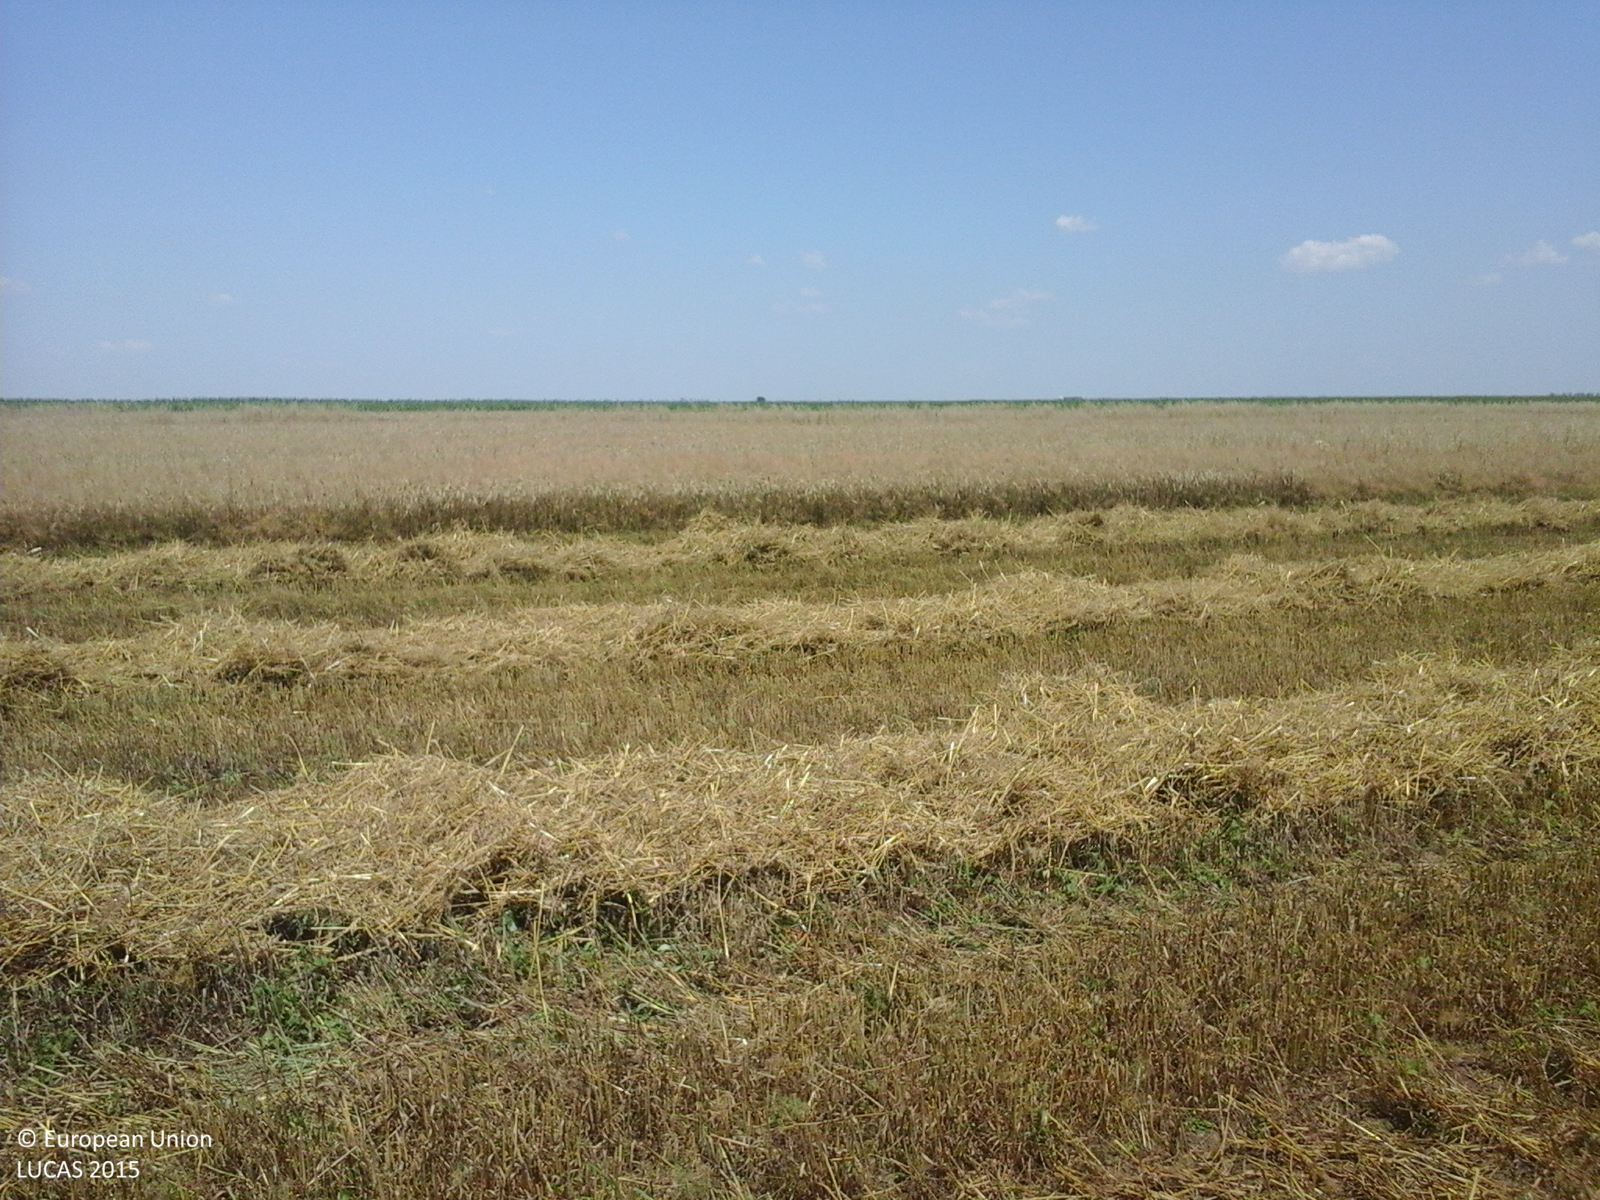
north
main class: Cropland
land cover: Common wheat
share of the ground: < 10 %
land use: Agriculture (excluding fallow land and kitchen gardens)
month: July
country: RO
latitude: 44.1872
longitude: 24.7476
